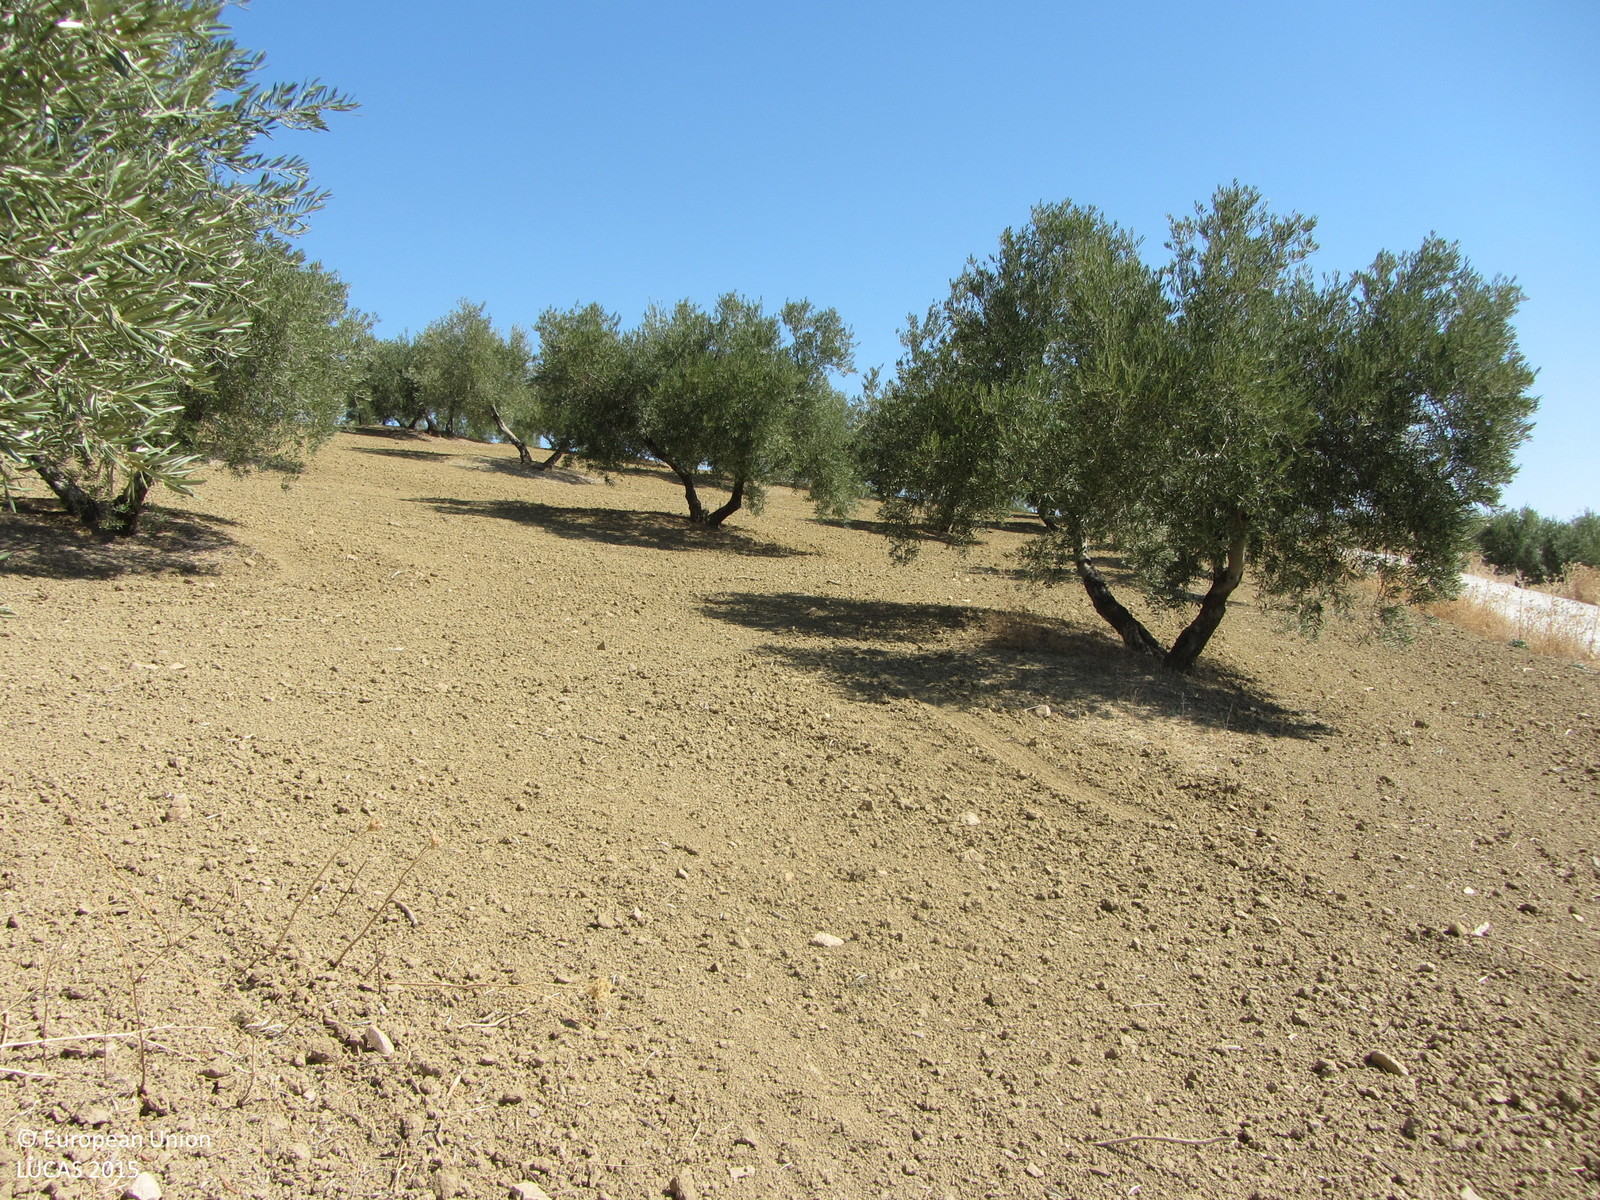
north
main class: Cropland
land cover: Olive groves
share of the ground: 25 - 50 %
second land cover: Other bare soil
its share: > 75 %
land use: Agriculture (excluding fallow land and kitchen gardens)
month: July
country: ES
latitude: 37.8838
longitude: -3.8632
